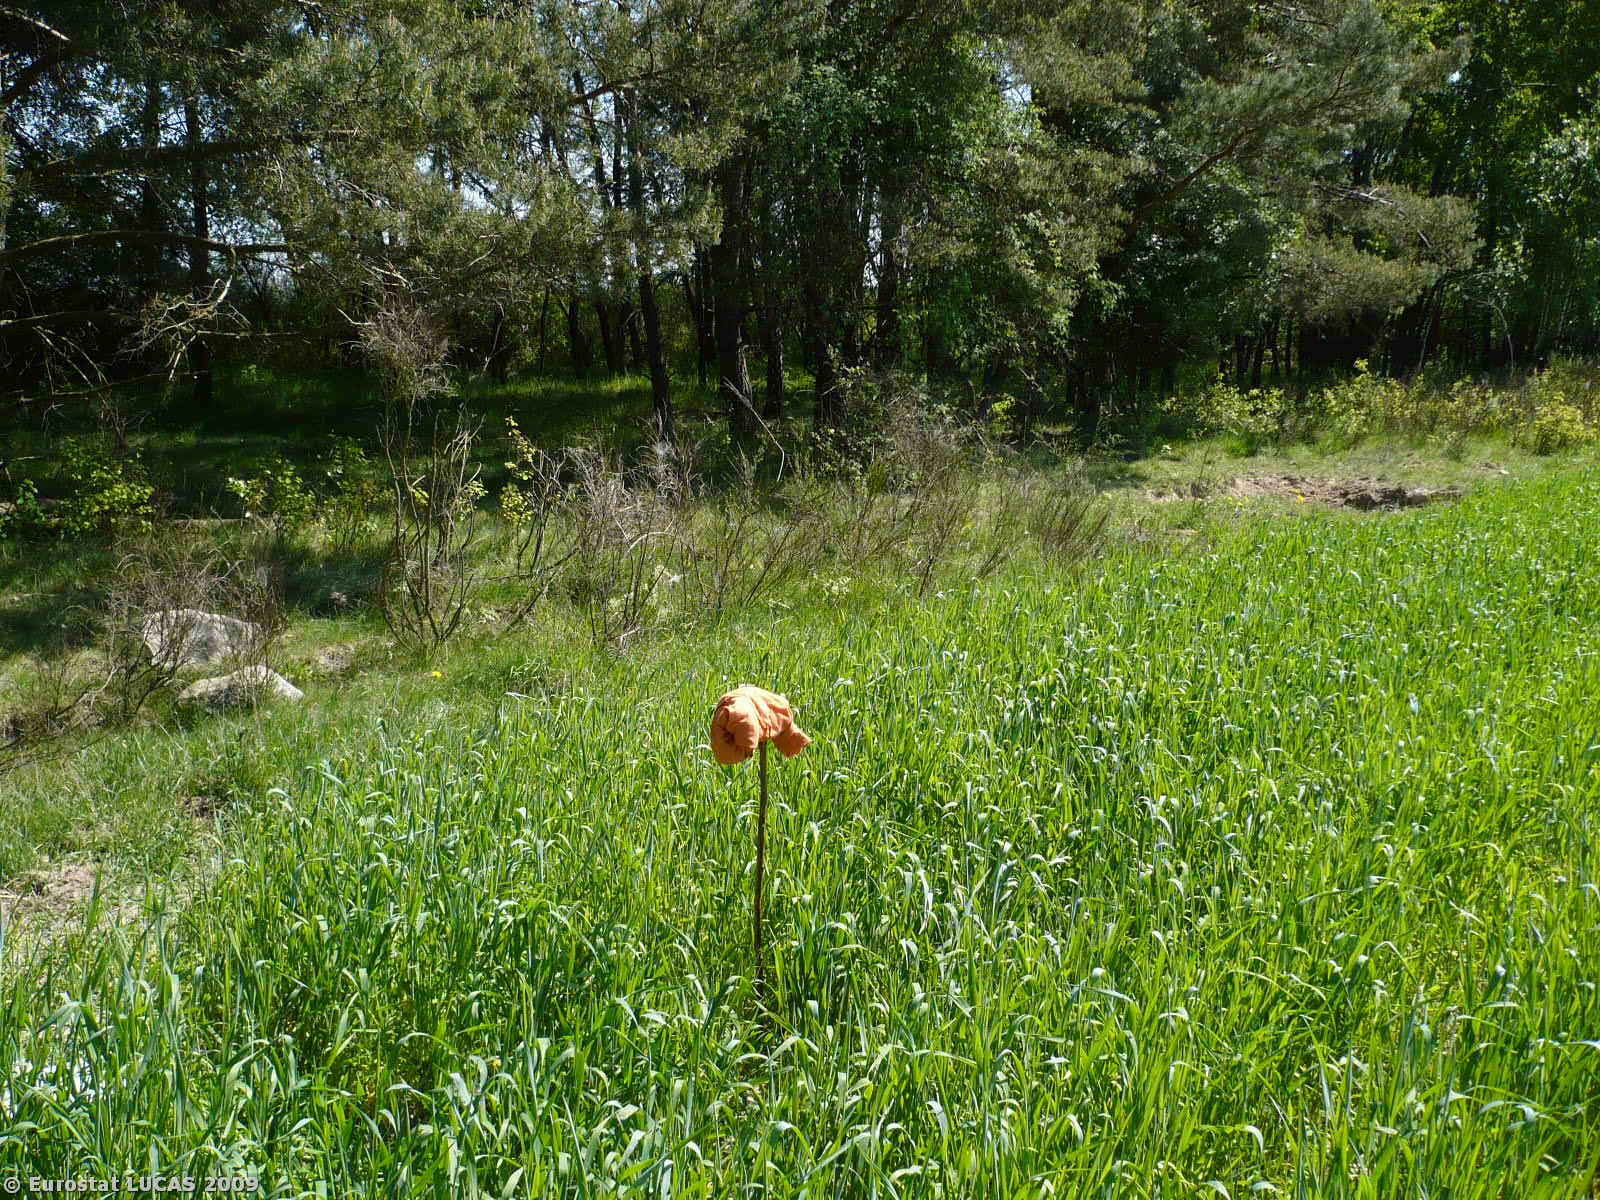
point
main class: Cropland
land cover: Rye
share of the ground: > 75 %
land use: Agriculture (excluding fallow land and kitchen gardens)
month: May
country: PL
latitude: 52.1689
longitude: 15.6922
